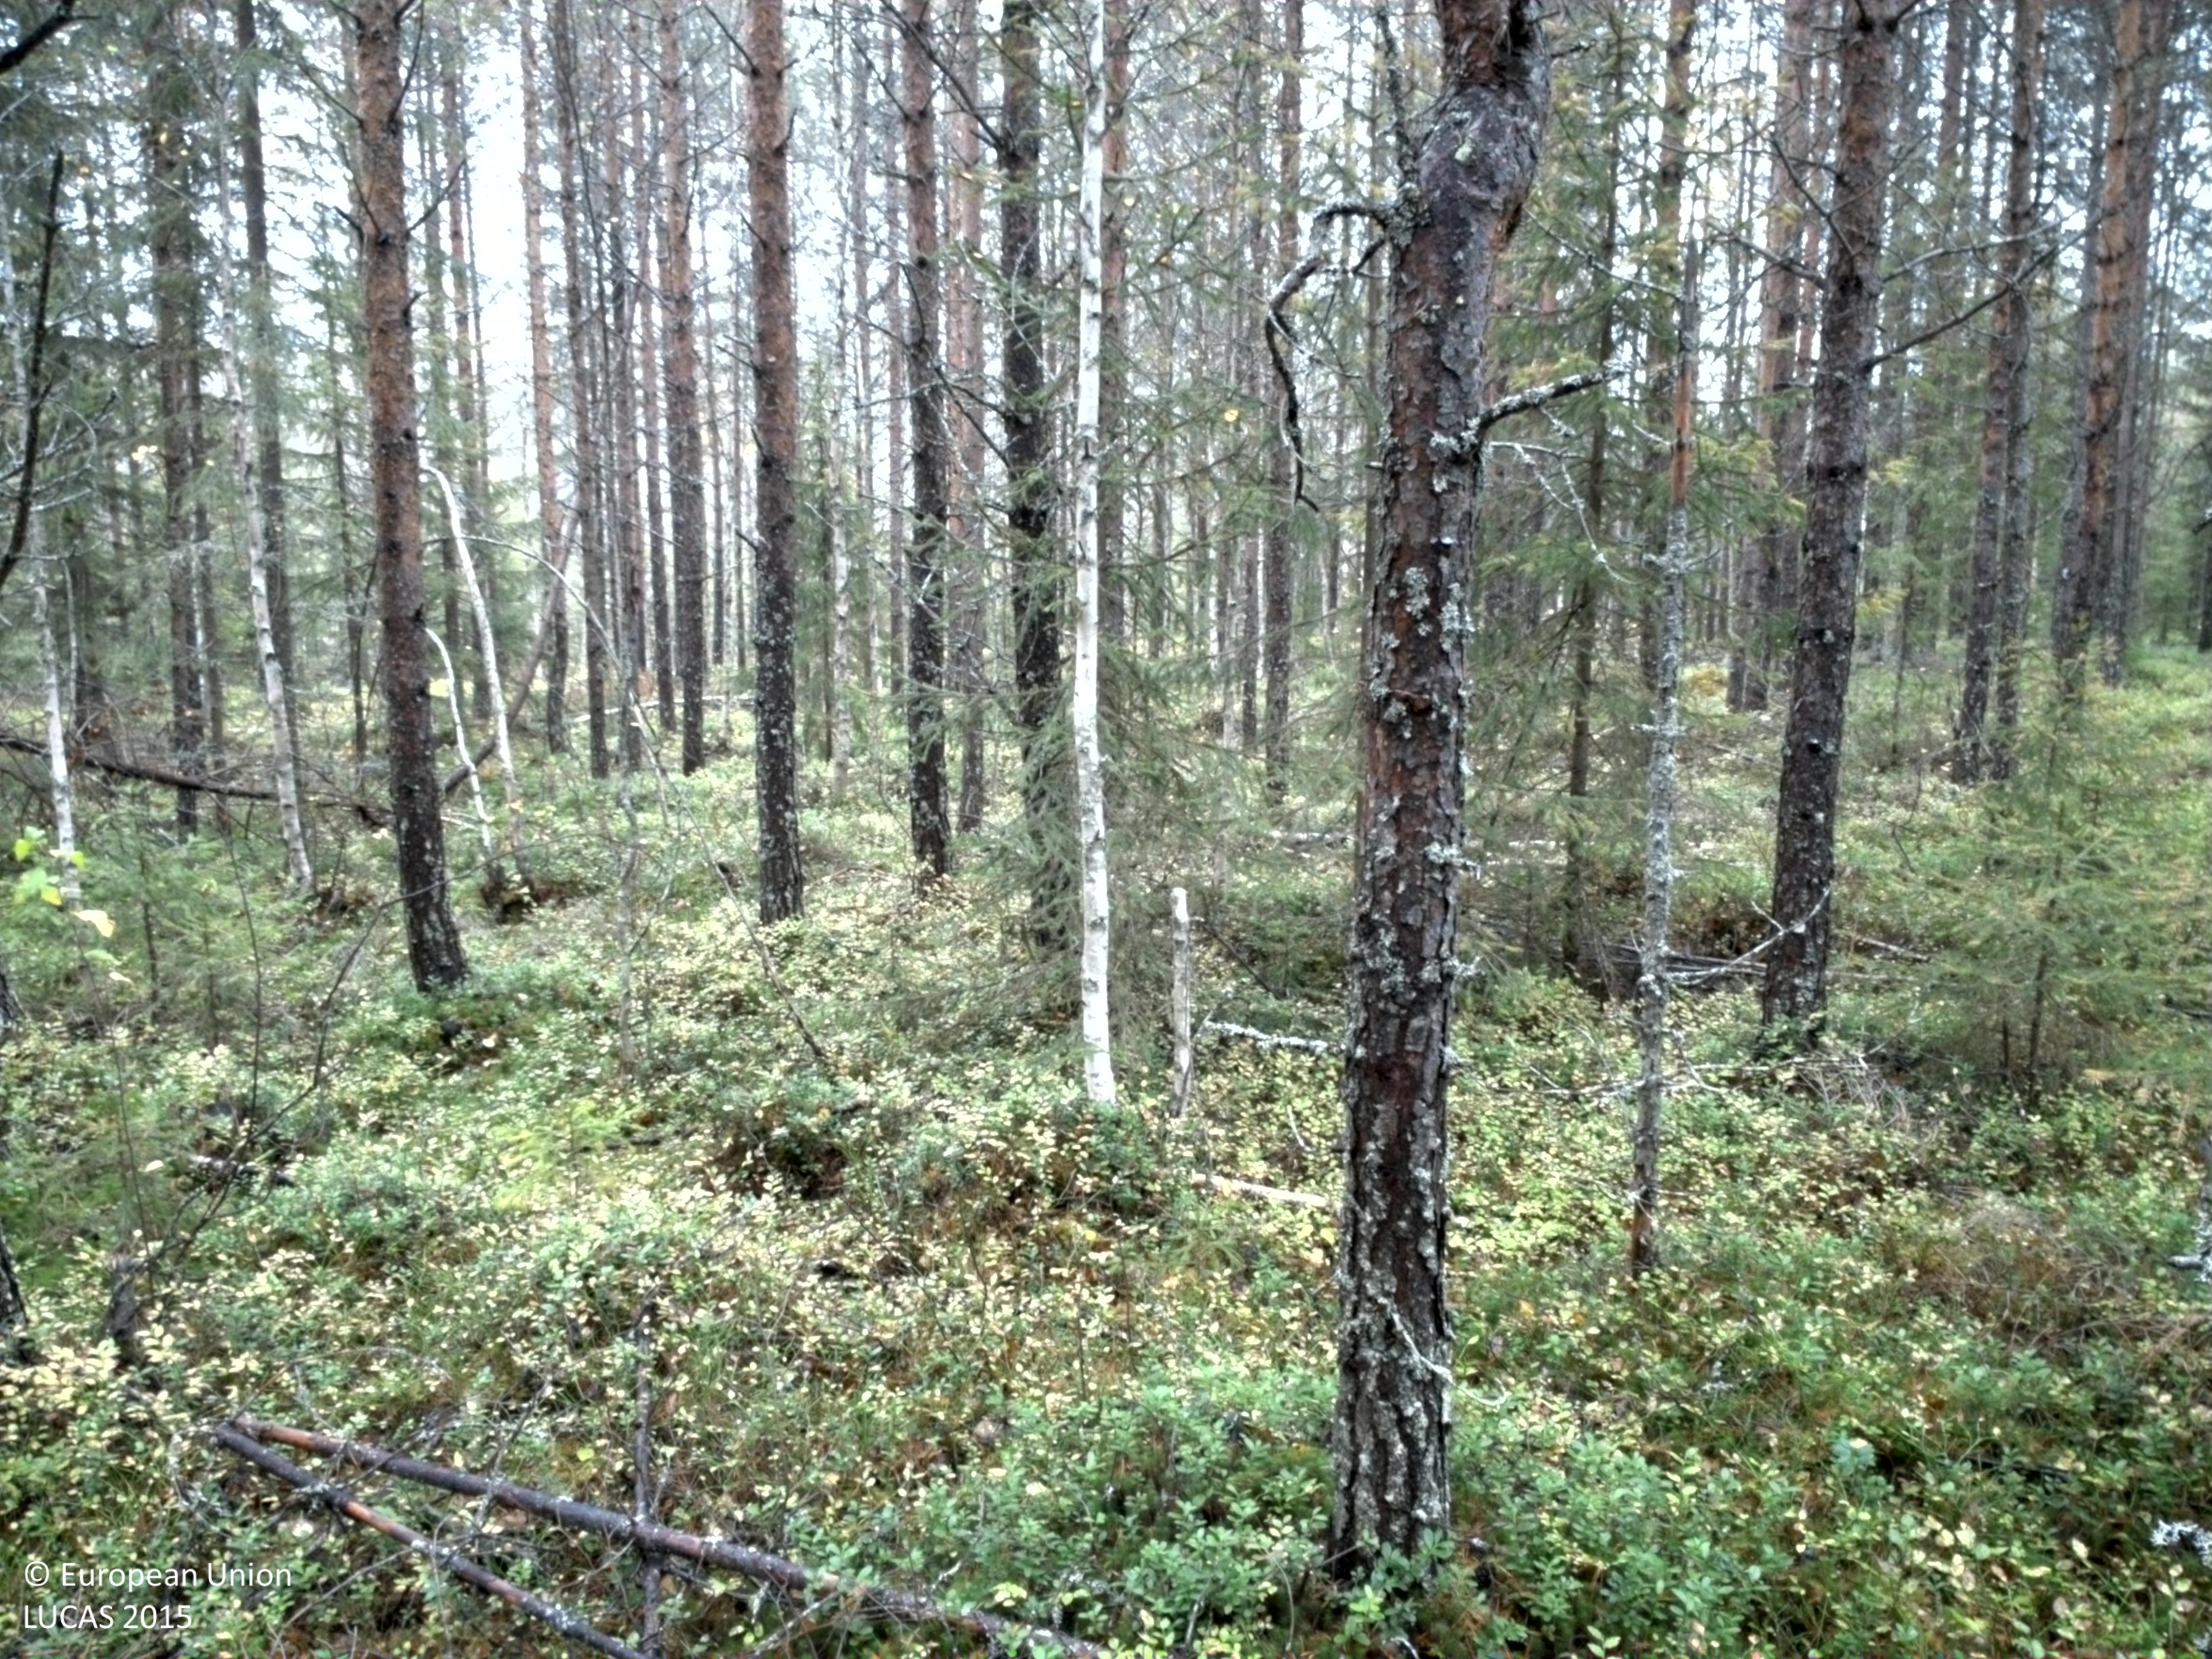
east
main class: Woodland
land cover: Pine dominated coniferous woodland
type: boreal forest
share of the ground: 25 - 50 %
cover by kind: shrubs 60 %, coniferous forest trees 40 %
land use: Forestry
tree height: > 5 m
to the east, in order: Pine dominated coniferous woodland; Tracks; Spruce dominated mixed woodland; Pine dominated coniferous woodland; Grassland with sparse tree/shrub cover; Pine dominated coniferous woodland; Grassland with sparse tree/shrub cover; Pine dominated coniferous woodland
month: September
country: SE
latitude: 65.6926
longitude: 22.1046
